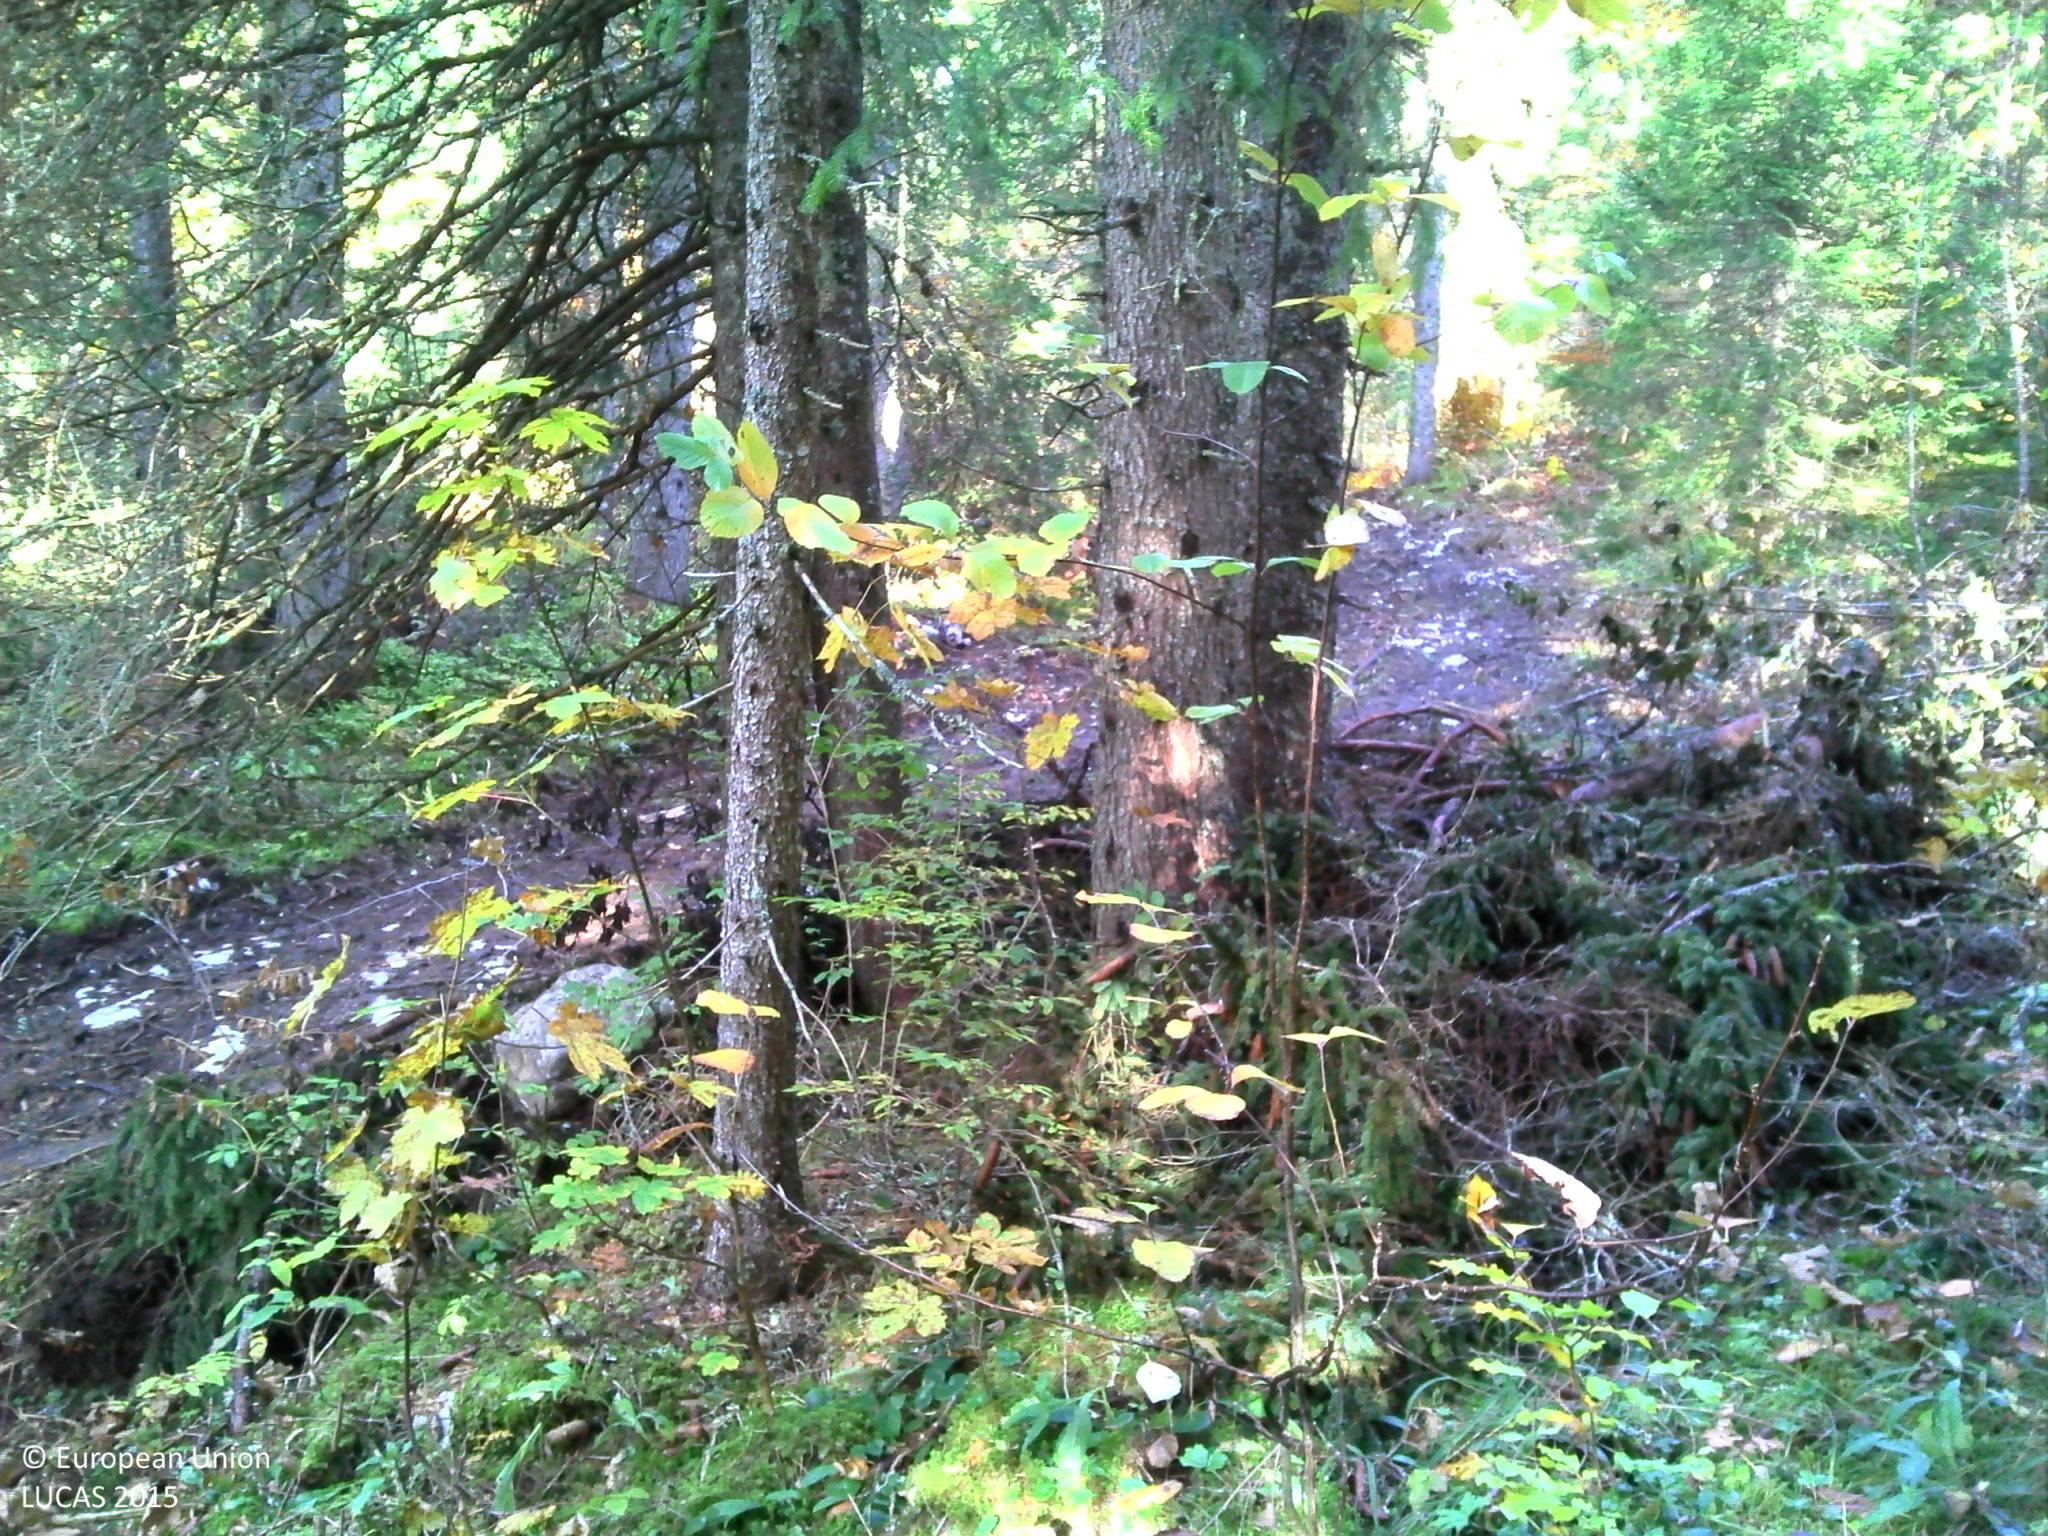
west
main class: Woodland
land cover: Spruce dominated coniferous woodland
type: hemiboreal forest and nemoral coniferous forest and mixed broadleaved-coniferous forest
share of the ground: > 75 %
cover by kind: coniferous forest trees 75 %, shrubs 10 %, herbaceous plants 10 %, broadleaved forest trees 5 %
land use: Forestry
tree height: > 5 m
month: October
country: FR
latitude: 46.6037
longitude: 6.0732
